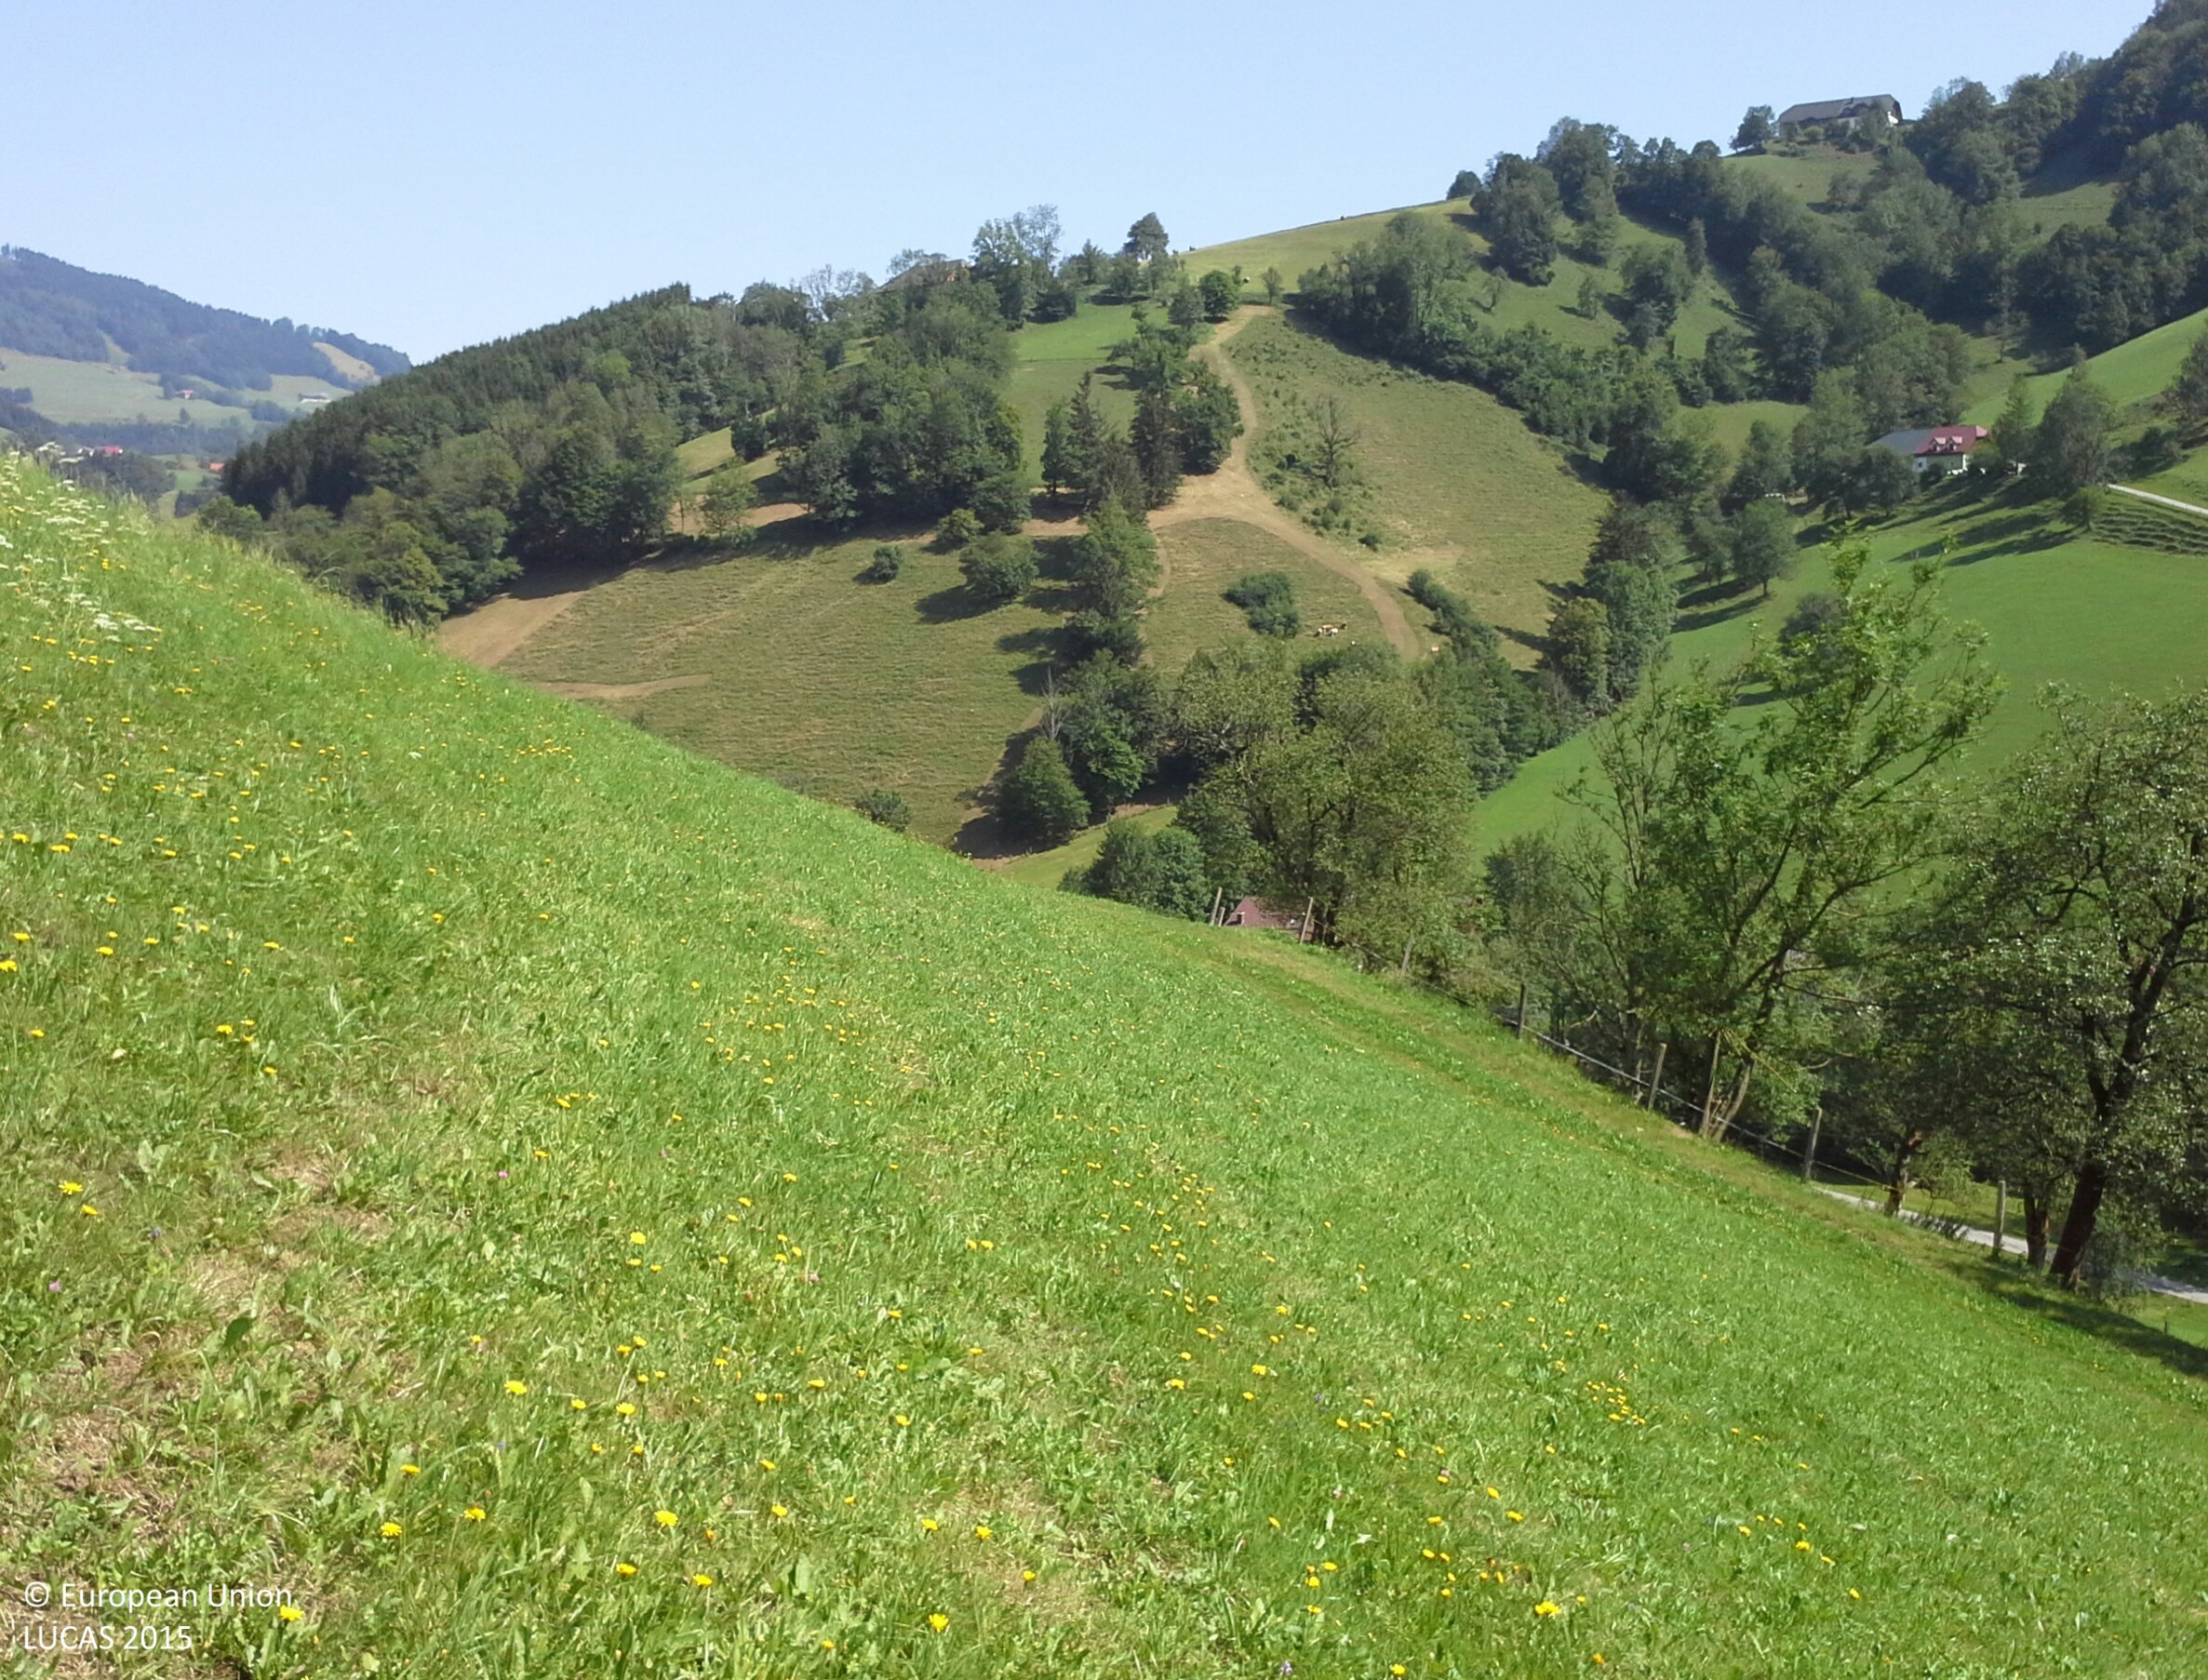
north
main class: Grassland
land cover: Grassland without tree/shrub cover
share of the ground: > 75 %
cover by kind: herbaceous plants 100 %
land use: Agriculture (excluding fallow land and kitchen gardens)
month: July
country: AT
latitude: 47.9117
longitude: 14.5893
